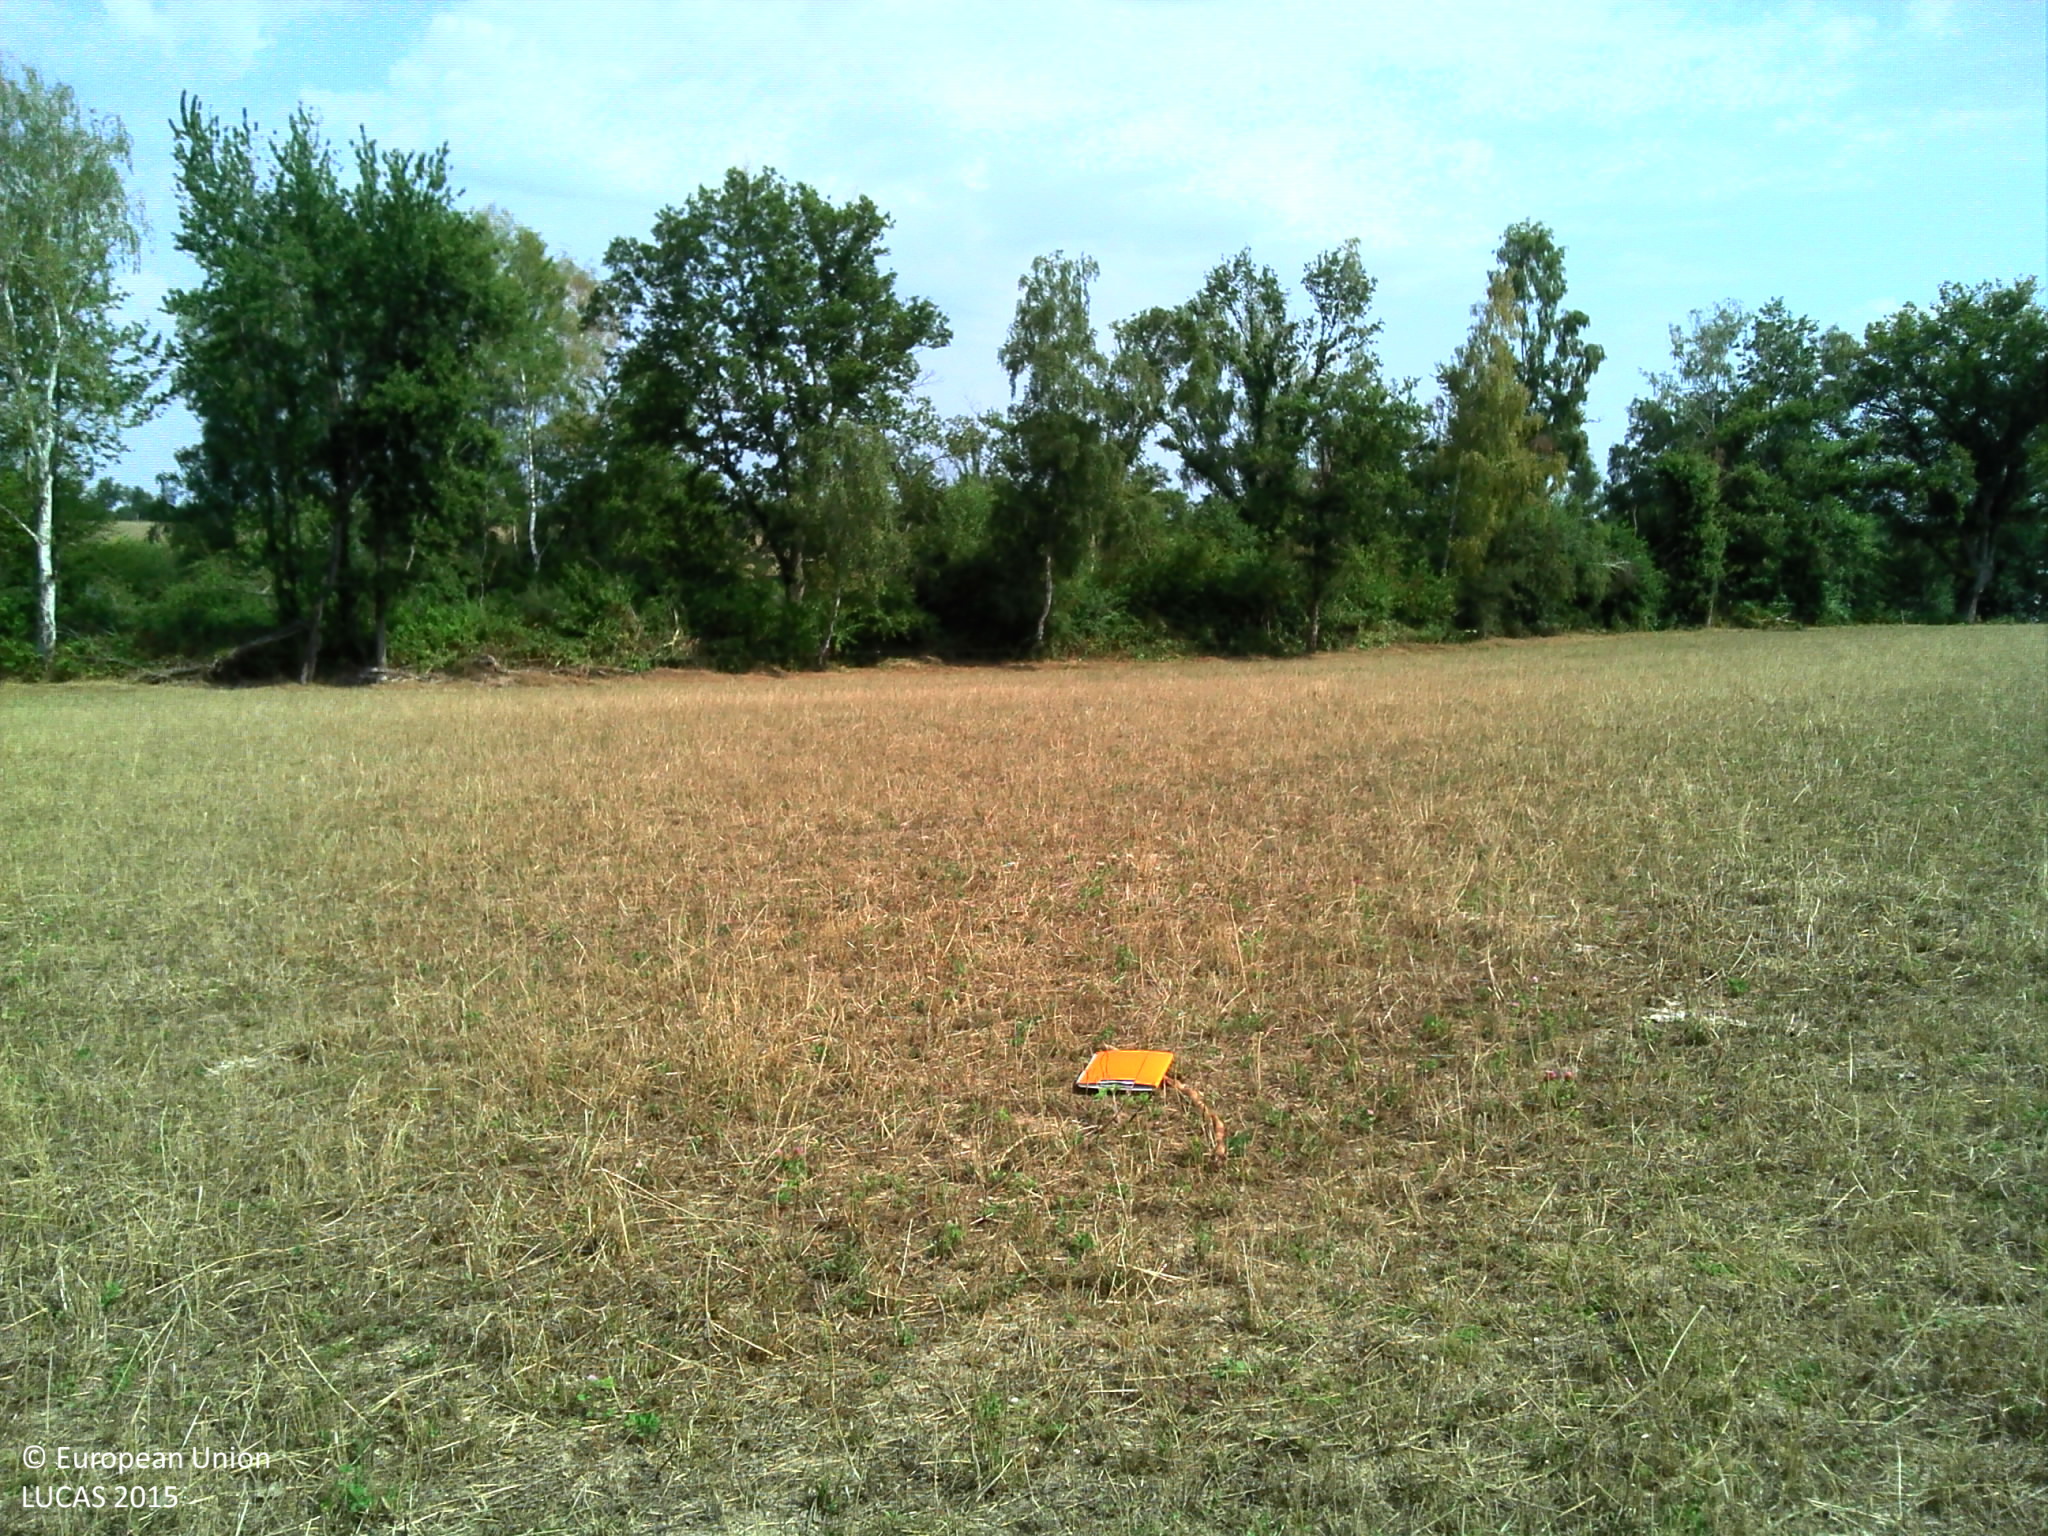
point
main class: Cropland
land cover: Temporary grasslands
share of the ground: > 75 %
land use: Agriculture (excluding fallow land and kitchen gardens)
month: August
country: FR
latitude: 46.6967
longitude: 2.9476
